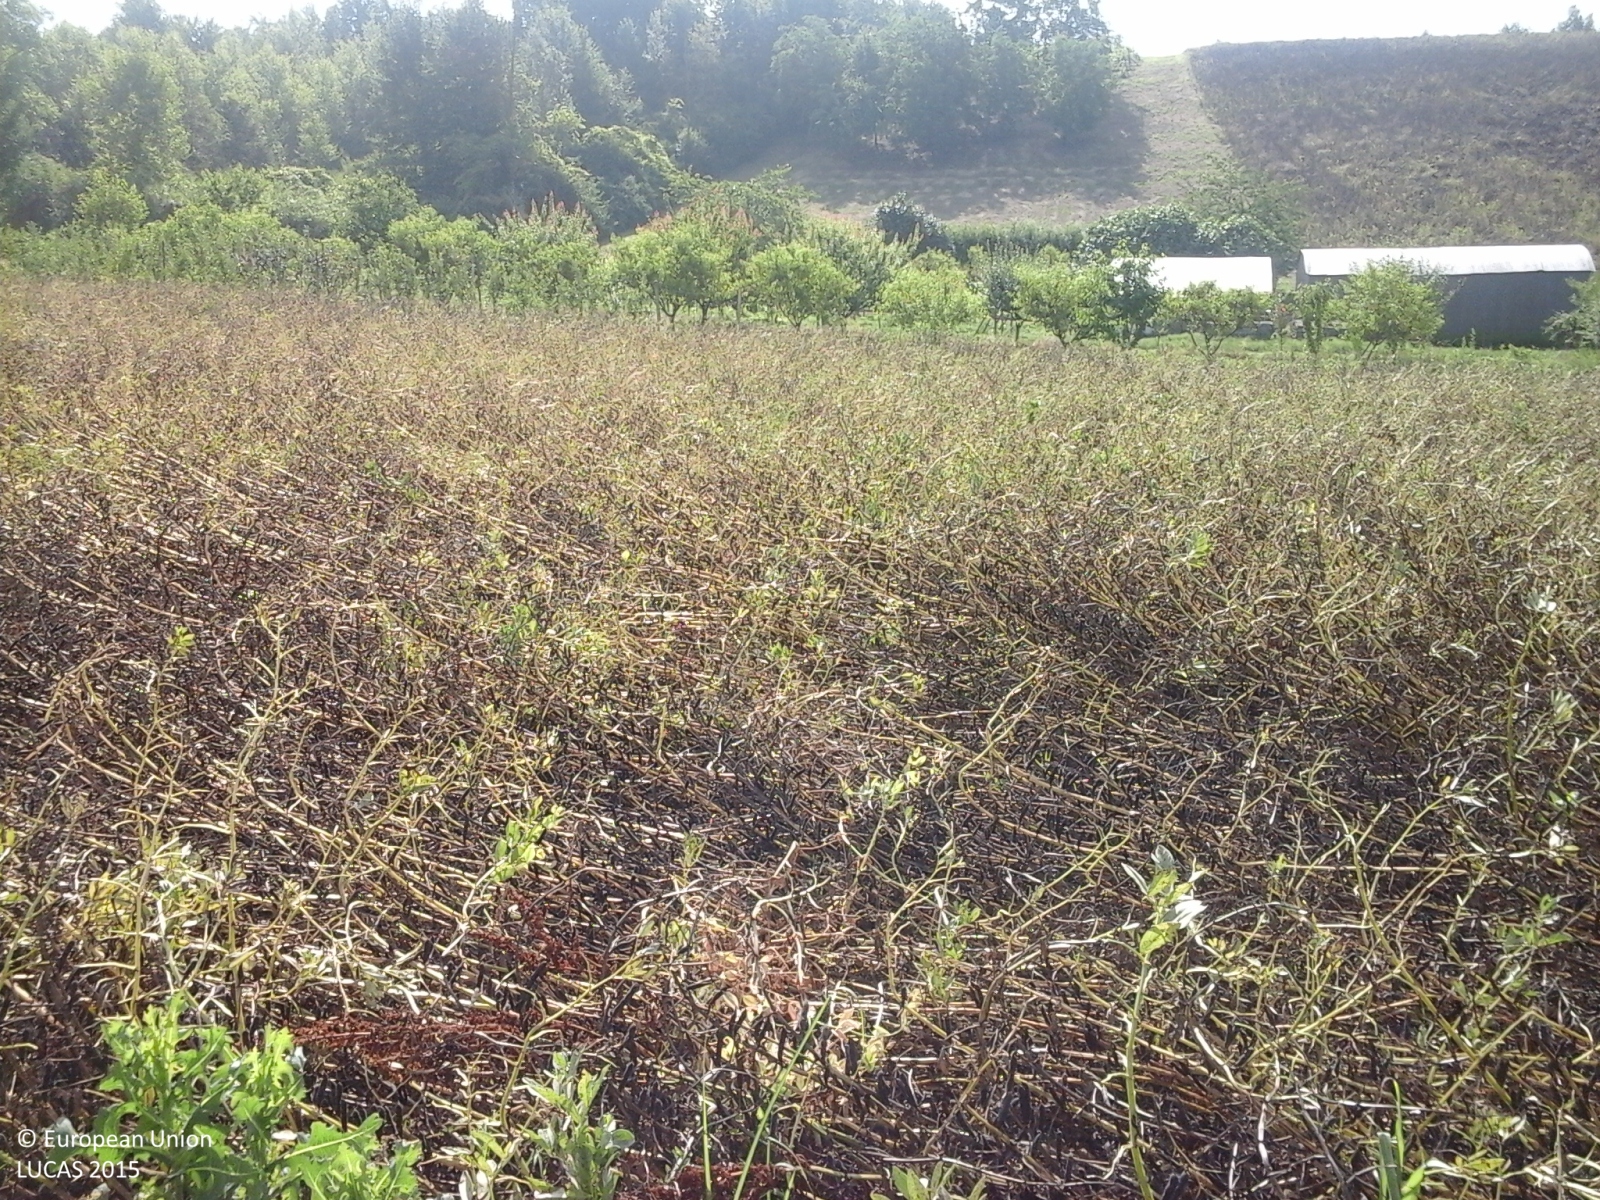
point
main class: Cropland
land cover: Dry pulses
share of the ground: > 75 %
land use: Agriculture (excluding fallow land and kitchen gardens)
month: June
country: IT
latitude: 44.9682
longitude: 8.3169
